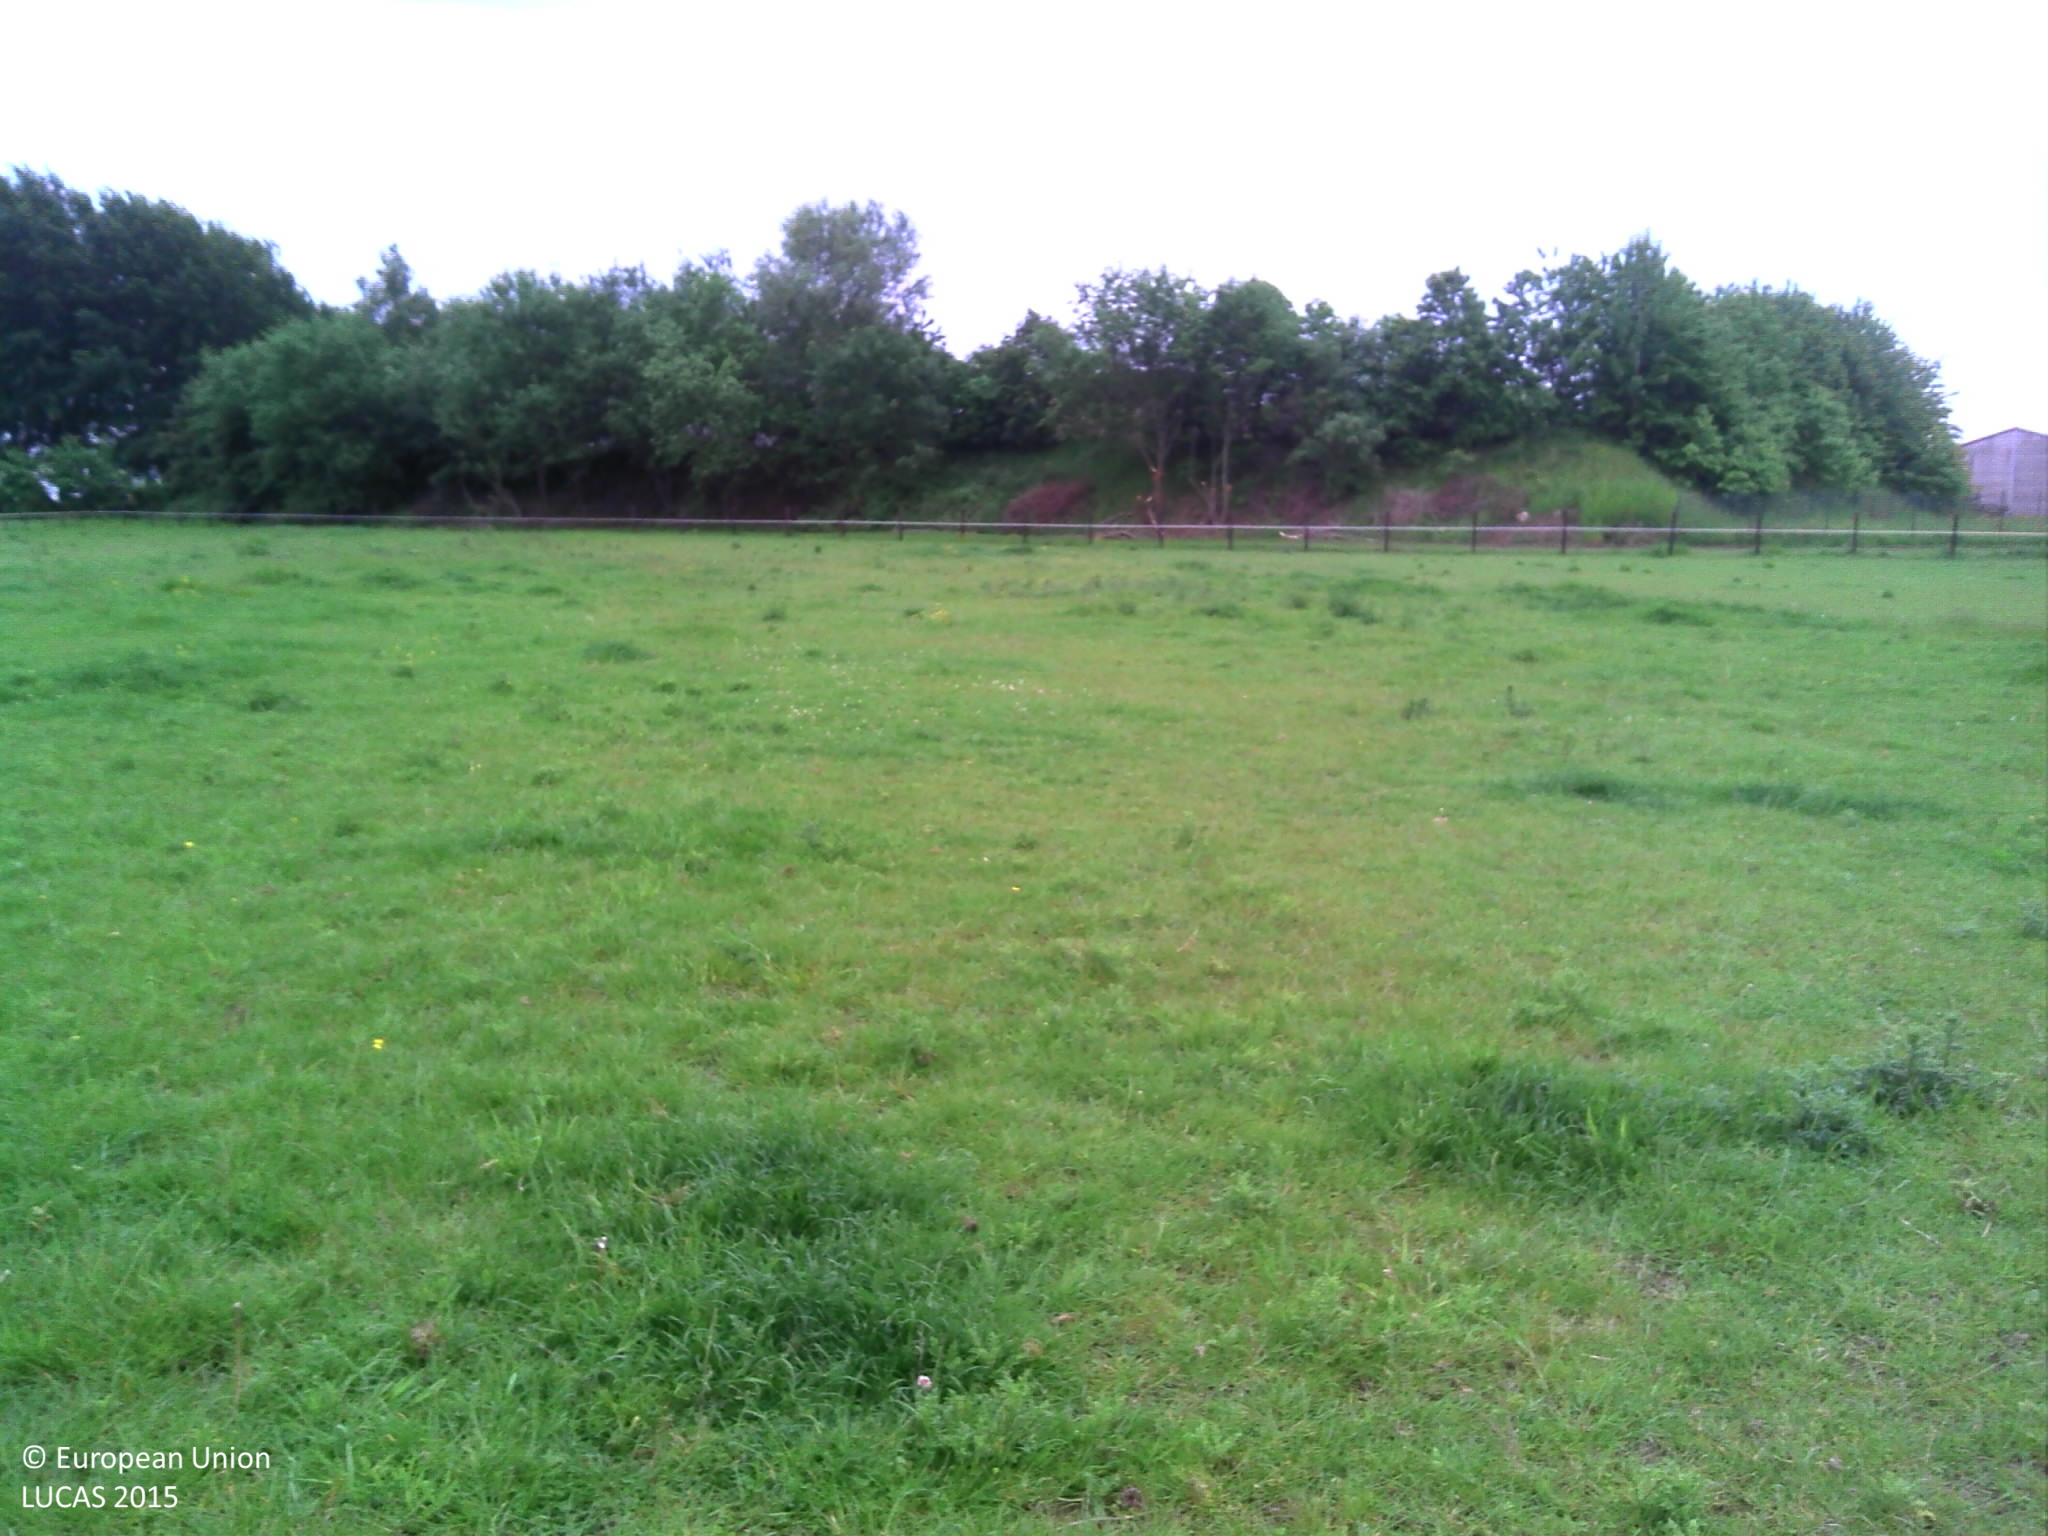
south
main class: Grassland
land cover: Grassland without tree/shrub cover
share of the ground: > 75 %
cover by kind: herbaceous plants 100 %
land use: Agriculture (excluding fallow land and kitchen gardens)
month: June
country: BE
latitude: 50.8817
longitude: 3.8106
